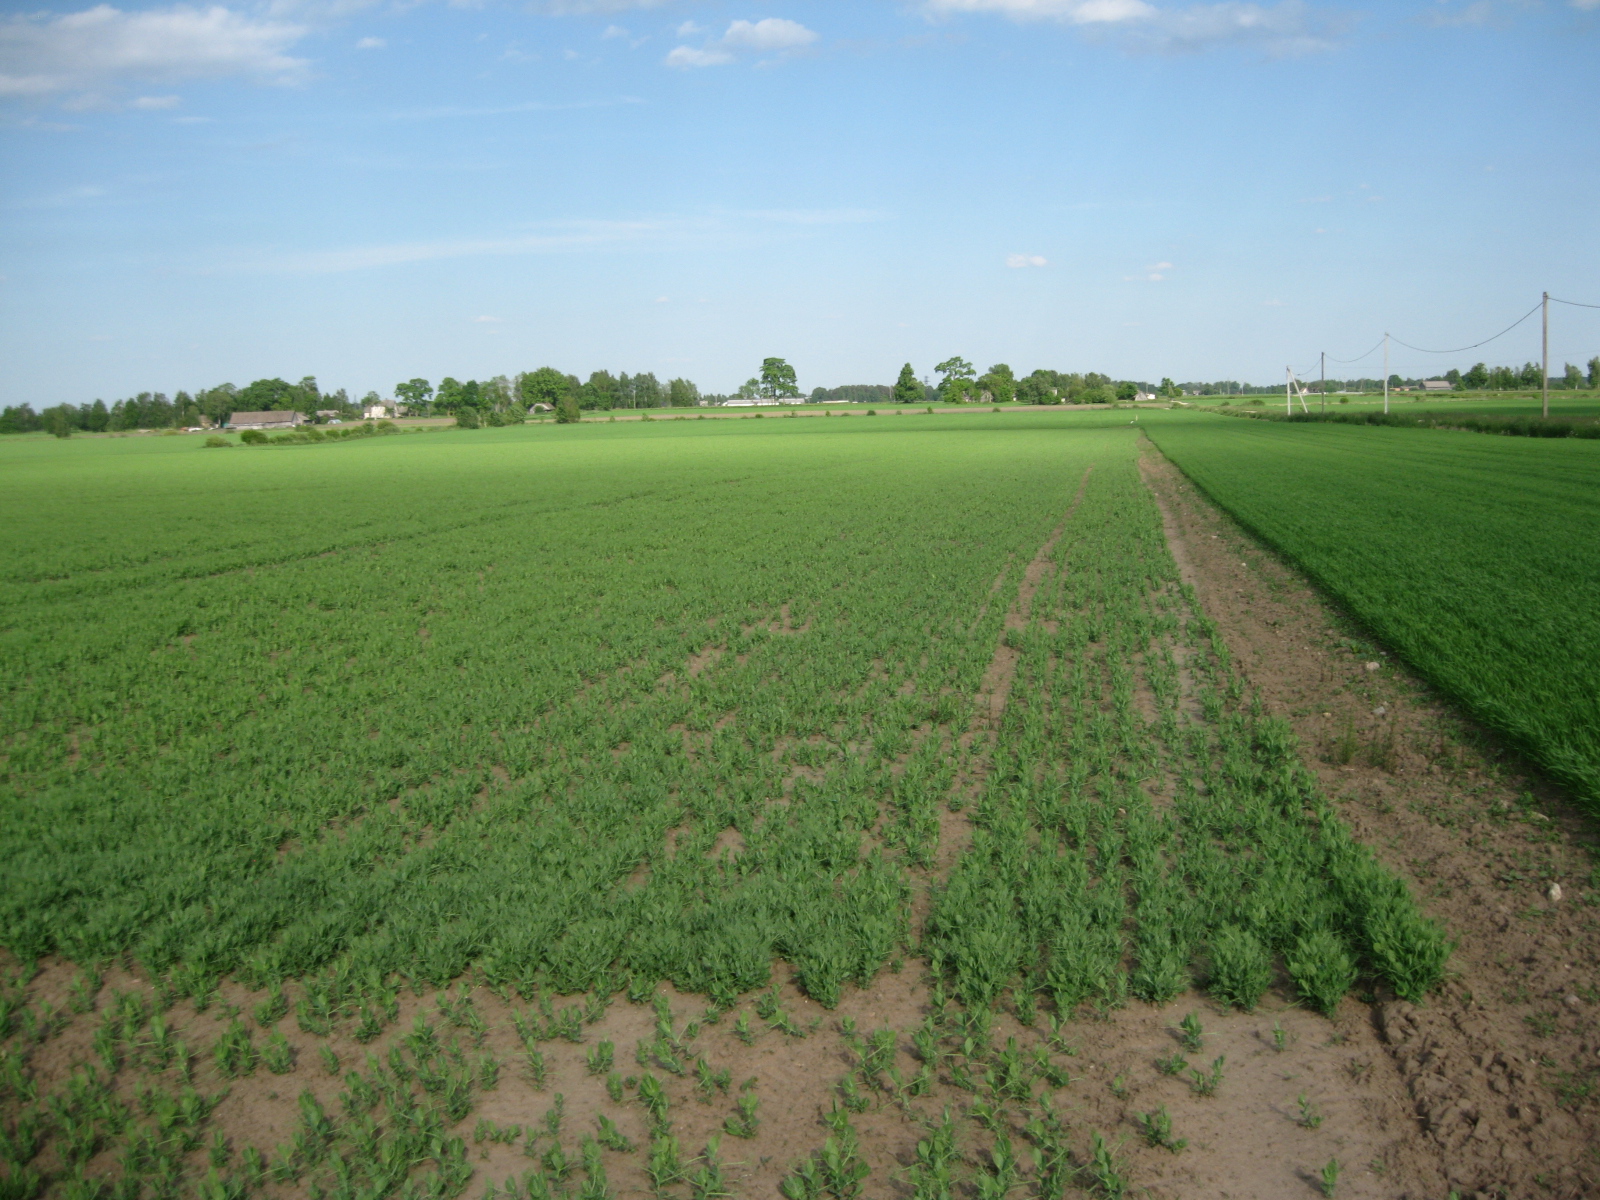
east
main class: Cropland
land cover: Dry pulses
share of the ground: 50 - 75 %
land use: Agriculture (excluding fallow land and kitchen gardens)
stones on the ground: < 10 %
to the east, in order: Dry pulses; Common wheat
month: June
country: LT
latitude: 55.7517
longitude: 24.0950
